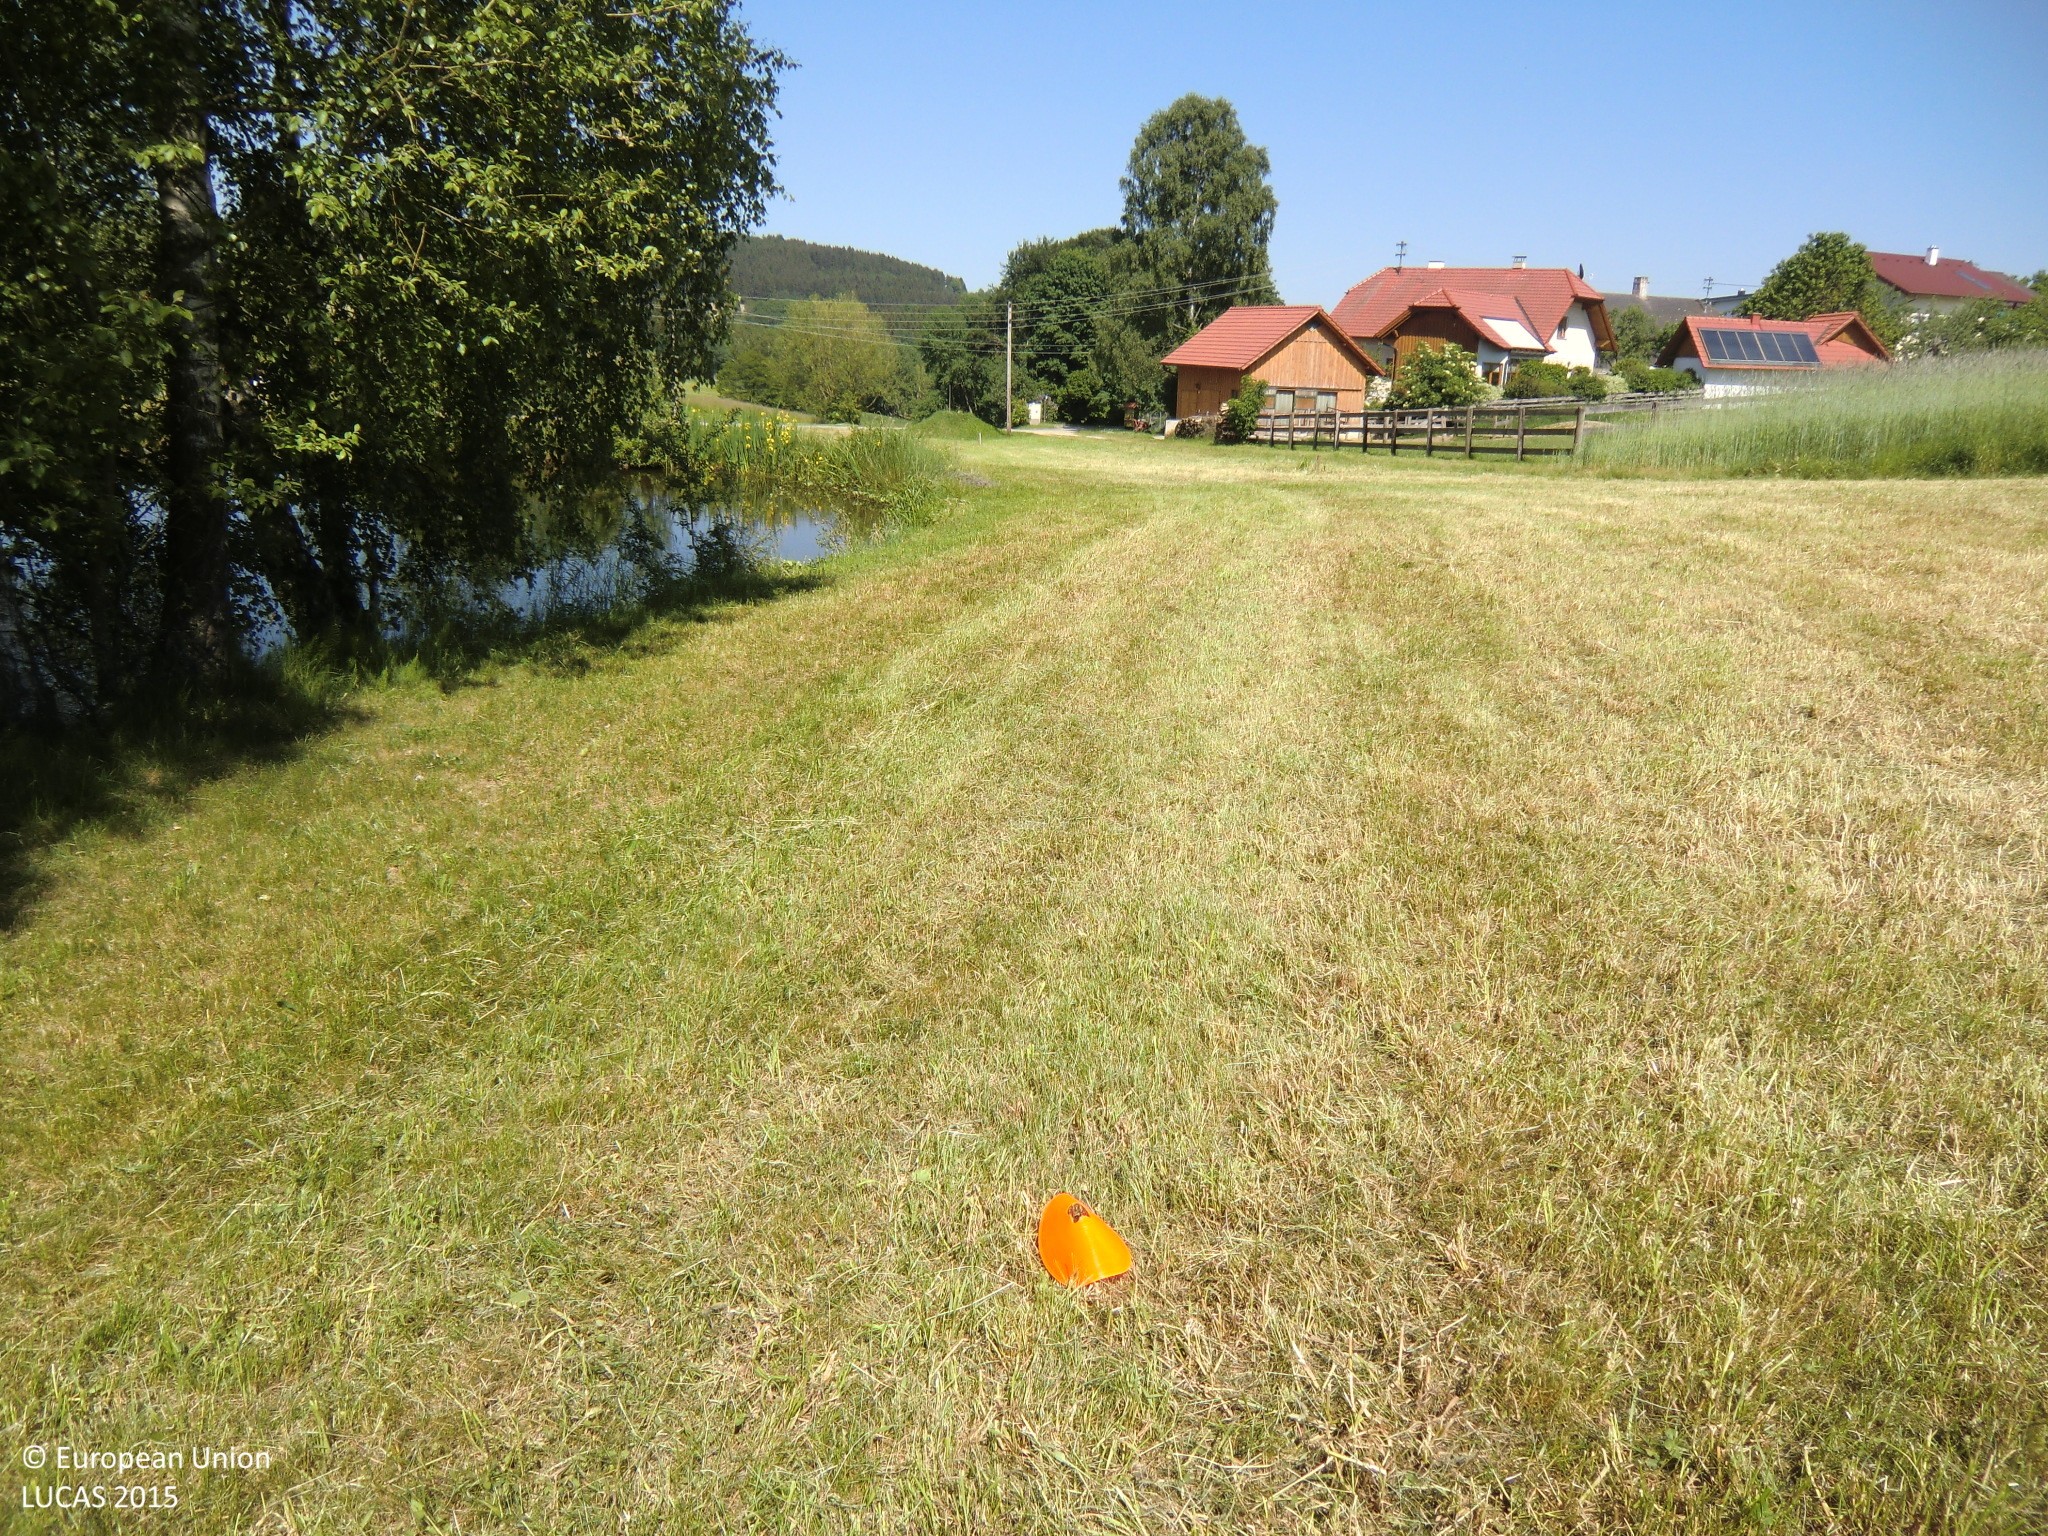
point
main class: Grassland
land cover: Grassland with sparse tree/shrub cover
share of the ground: > 75 %
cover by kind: herbaceous plants 95 %, broadleaved forest trees 5 %
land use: Agriculture (excluding fallow land and kitchen gardens)
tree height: > 5 m
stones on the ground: < 10 %
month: June
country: AT
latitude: 48.5321
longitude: 14.4018
